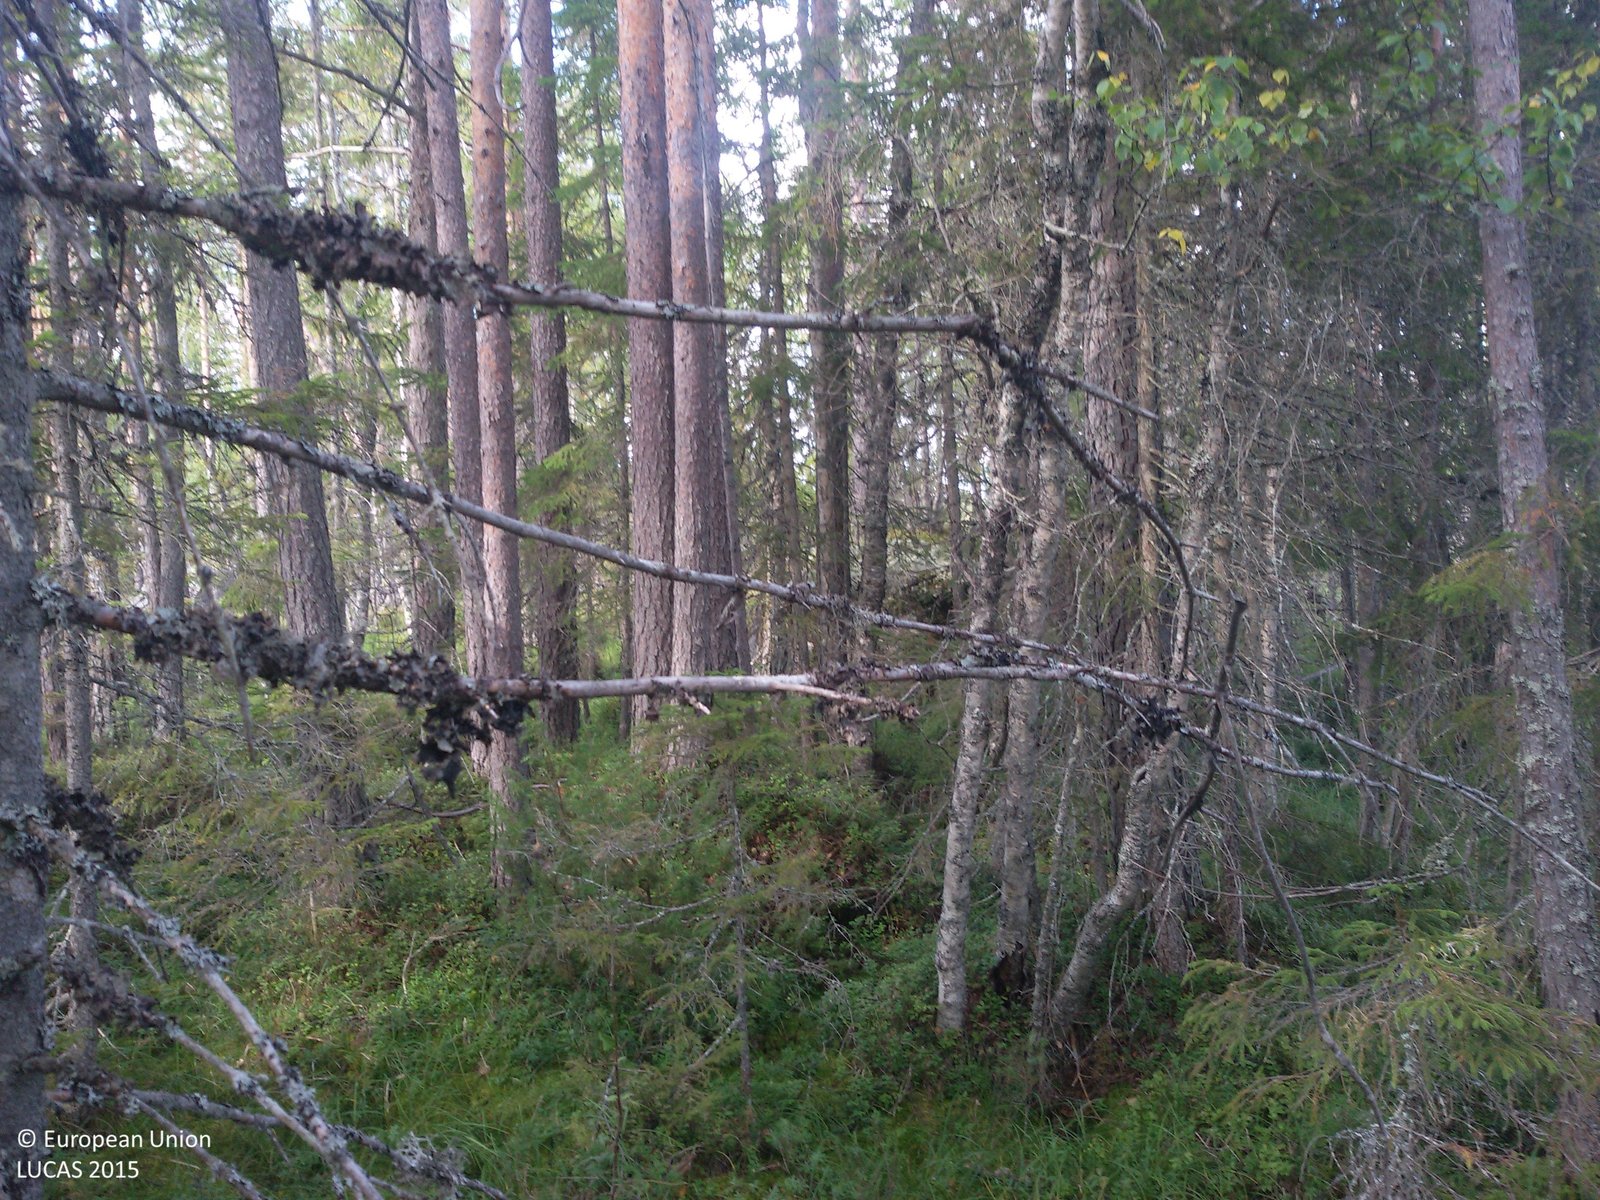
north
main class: Woodland
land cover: Pine dominated mixed woodland
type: boreal forest
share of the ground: 50 - 75 %
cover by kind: coniferous forest trees 45 %, broadleaved forest trees 25 %, herbaceous plants 15 %, lichens and mosses 15 %
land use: Forestry
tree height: > 5 m
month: September
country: SE
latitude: 60.8695
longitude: 15.4557
